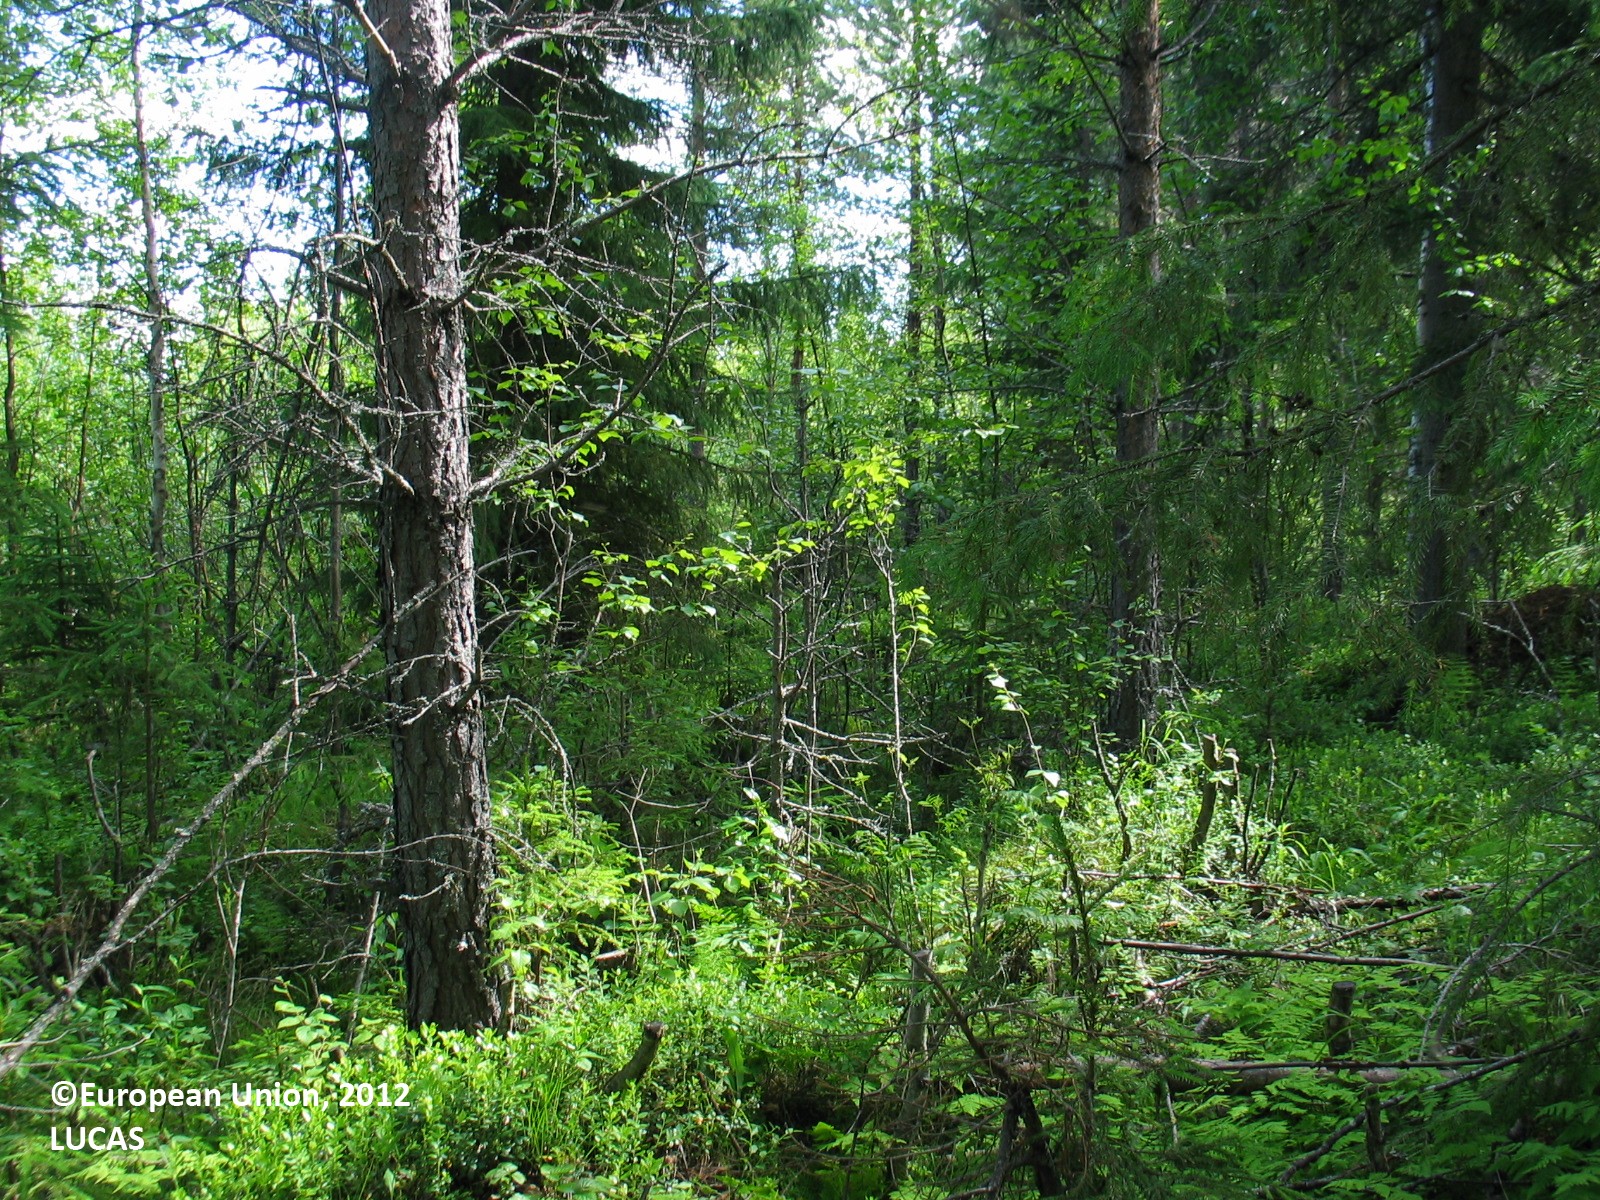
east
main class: Woodland
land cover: Other mixed woodland
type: boreal forest
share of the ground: > 75 %
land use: Forestry
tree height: > 5 m
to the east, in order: Other mixed woodland; Ditches and canals; Broadleaved woodland; Other mixed woodland; Inland running water; Spruce dominated coniferous woodland; Inland running water; Spruce dominated coniferous woodland
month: July
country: FI
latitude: 64.7214
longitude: 26.5900
